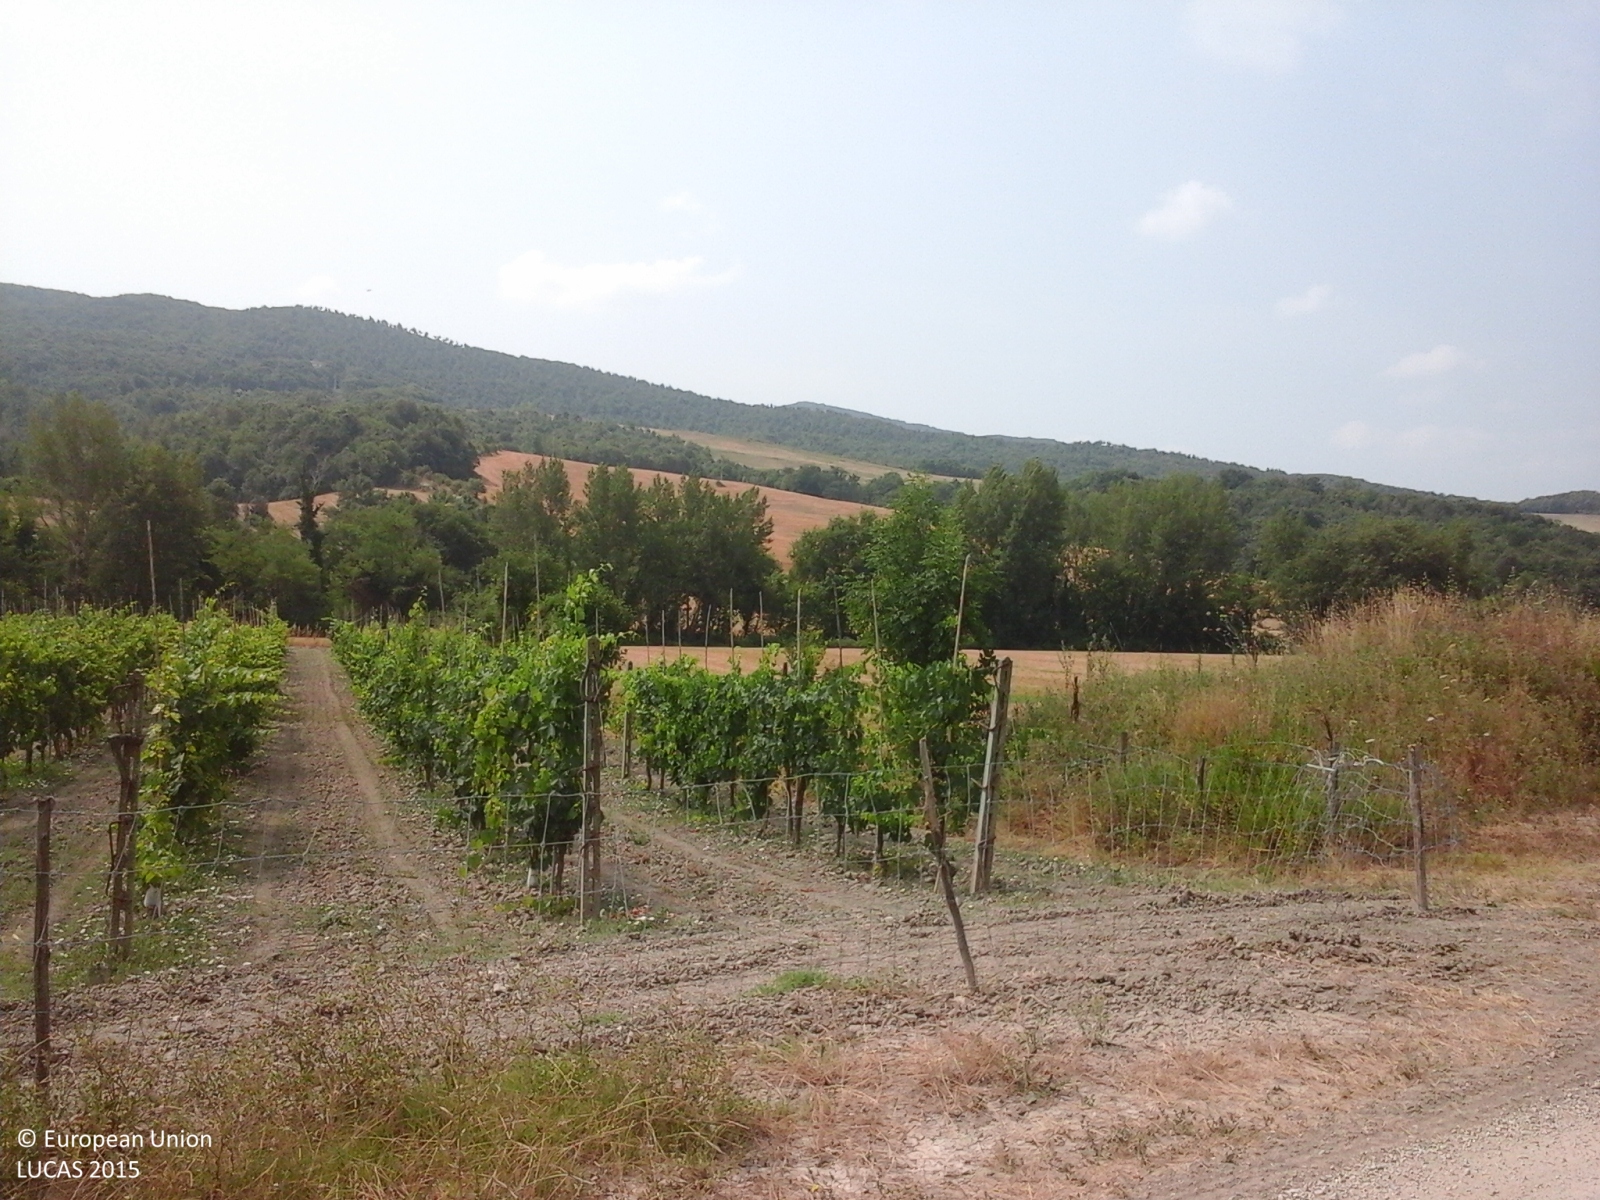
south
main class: Cropland
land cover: Oats
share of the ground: > 75 %
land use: Agriculture (excluding fallow land and kitchen gardens)
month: July
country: IT
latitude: 43.3719
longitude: 10.9475
